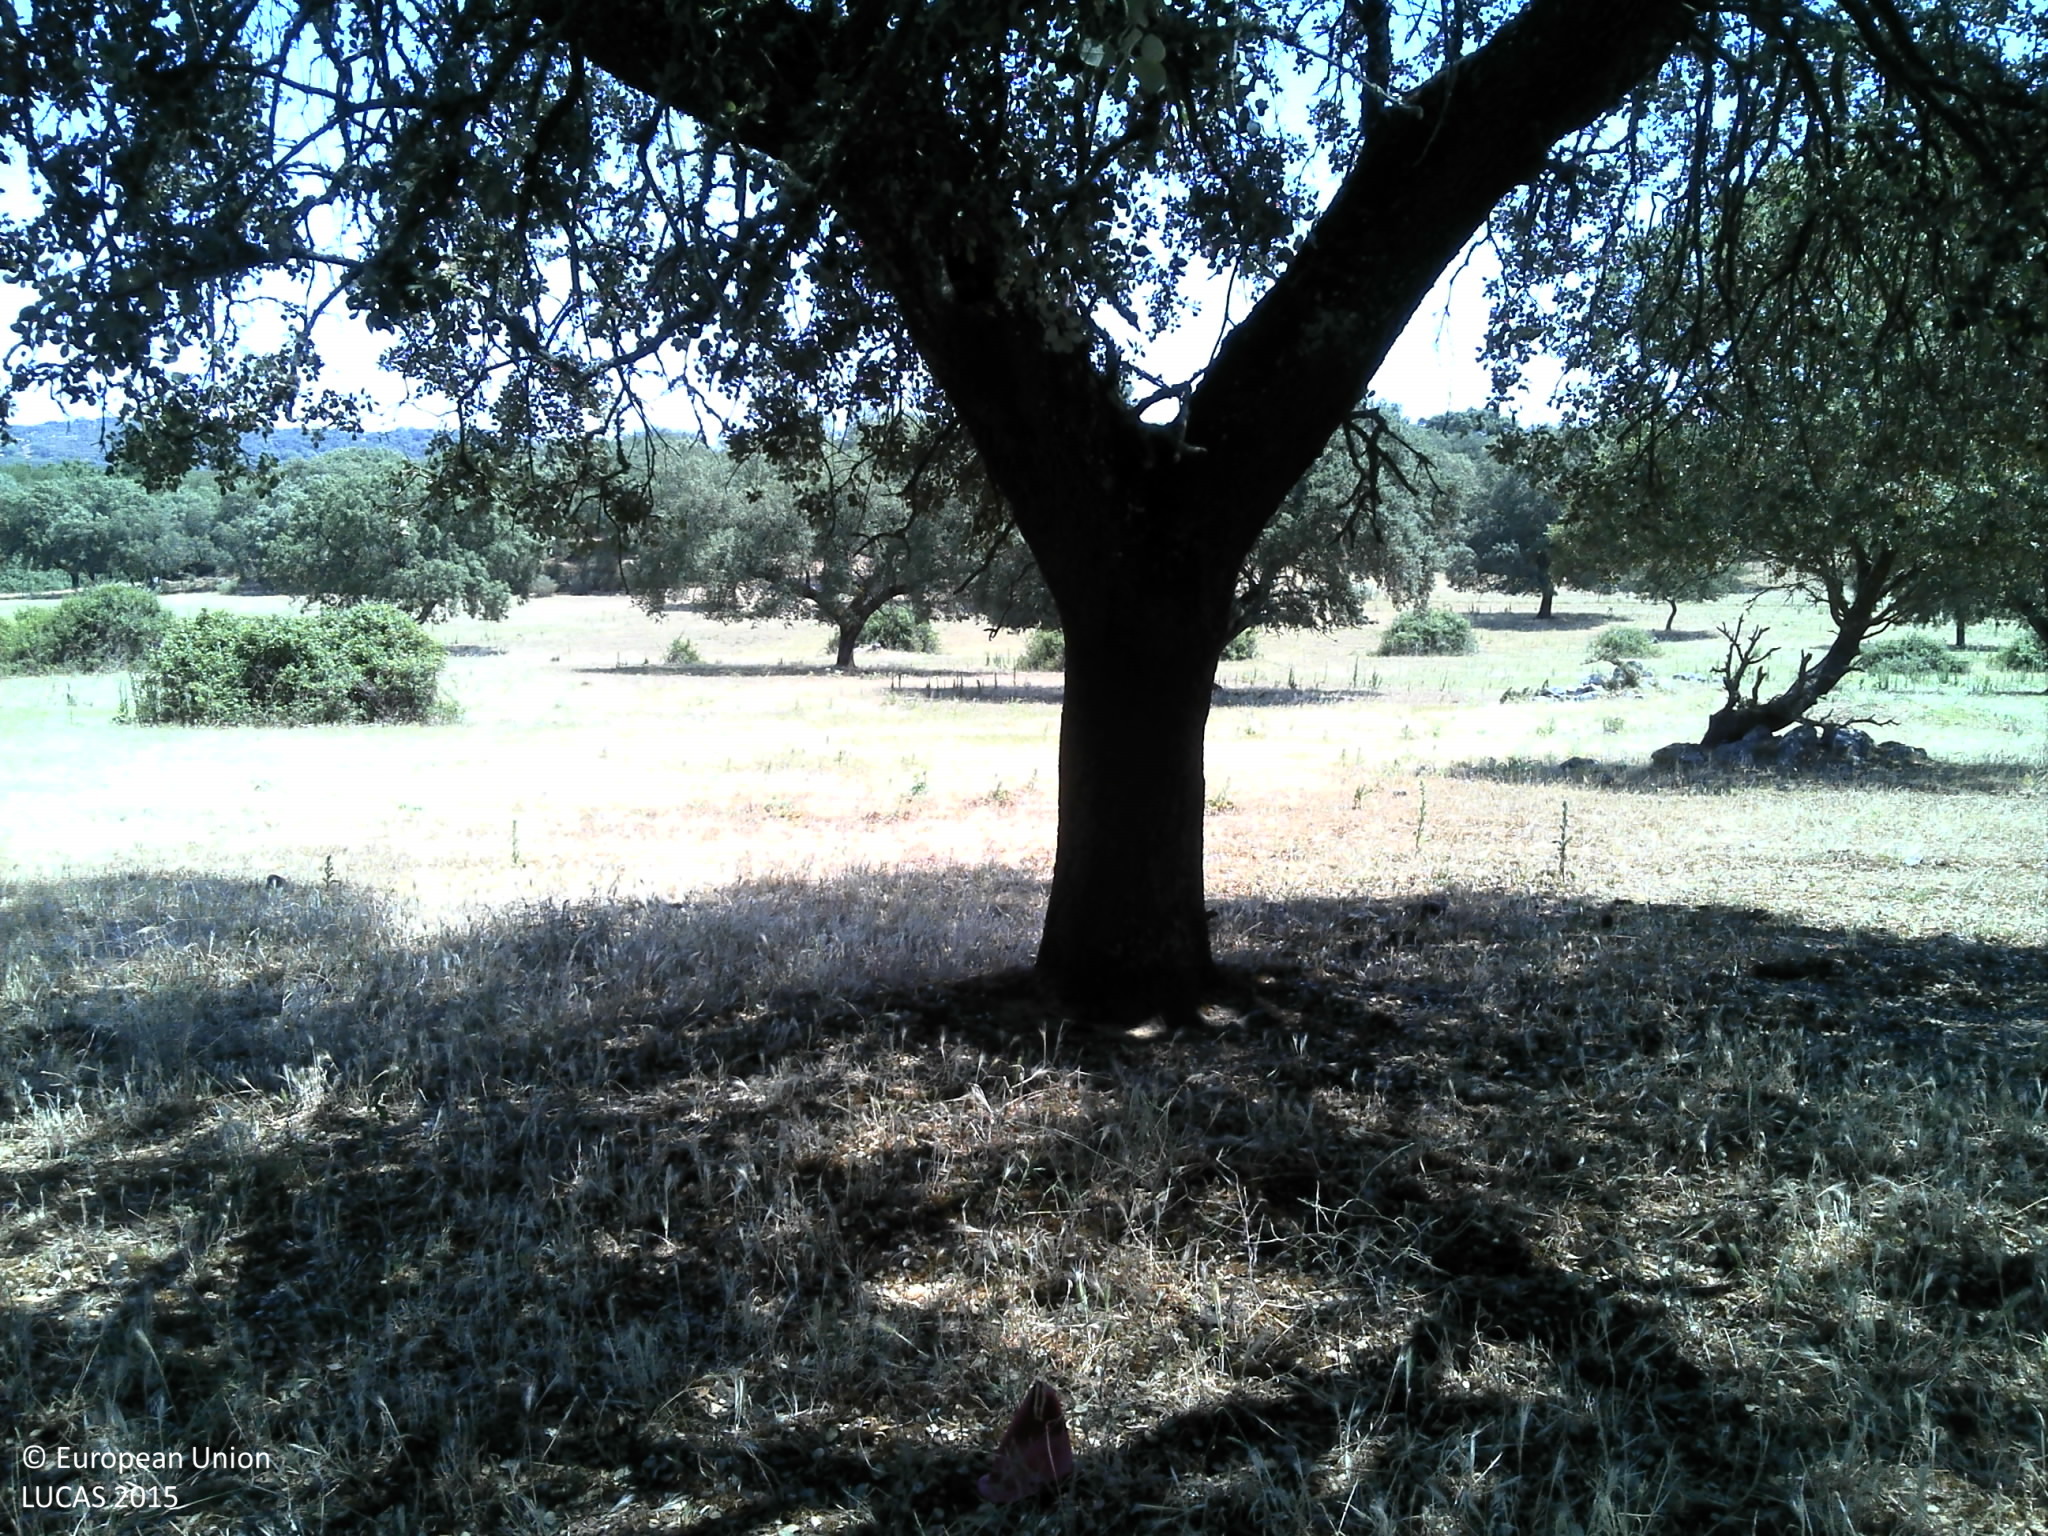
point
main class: Woodland
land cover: Broadleaved woodland
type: broadleaved evergreen forest
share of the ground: 25 - 50 %
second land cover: Grassland without tree/shrub cover
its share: 25 - 50 %
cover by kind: herbaceous plants 50 %, broadleaved forest trees 30 %, unconsolidated bare surface 20 %
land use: Forestry
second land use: Agriculture (excluding fallow land and kitchen gardens)
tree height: > 5 m
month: June
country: PT
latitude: 38.6561
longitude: -8.1222
